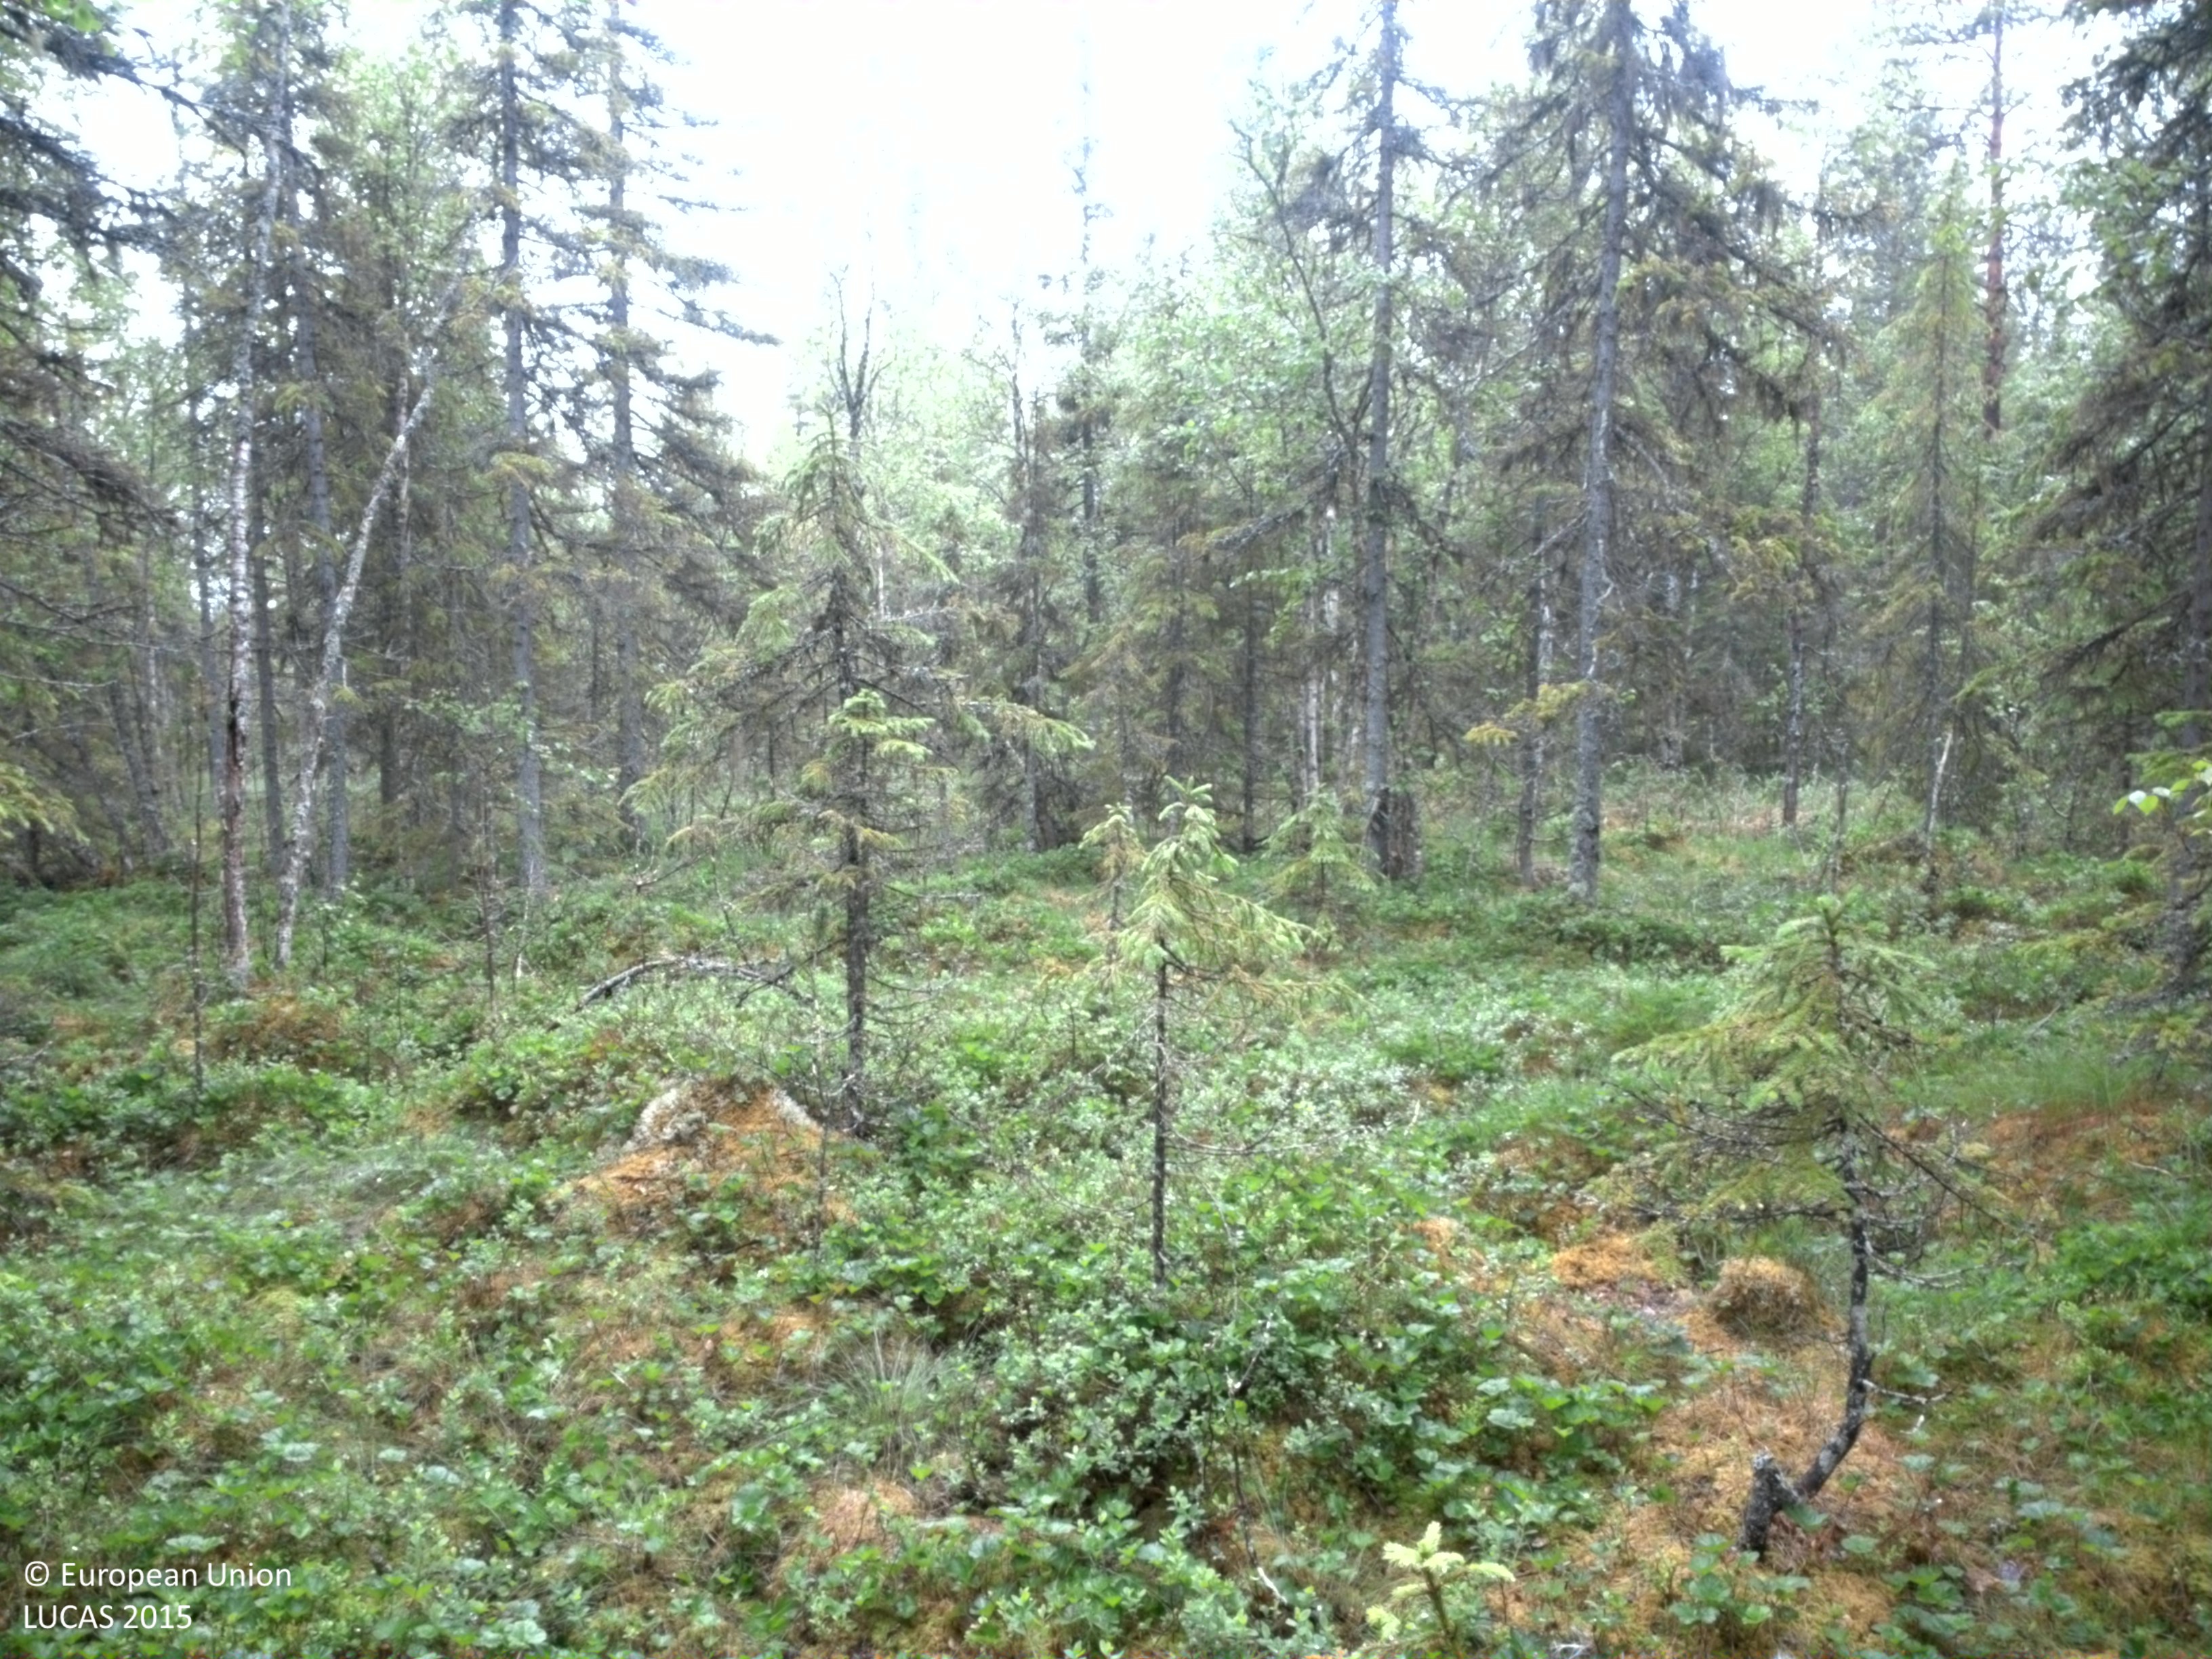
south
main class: Woodland
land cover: Spruce dominated mixed woodland
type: mire and swamp forests
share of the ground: 50 - 75 %
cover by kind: coniferous forest trees 45 %, lichens and mosses 20 %, broadleaved forest trees 15 %, shrubs 10 %, herbaceous plants 10 %
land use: Forestry
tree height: > 5 m
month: July
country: SE
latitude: 64.5628
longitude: 18.2931
